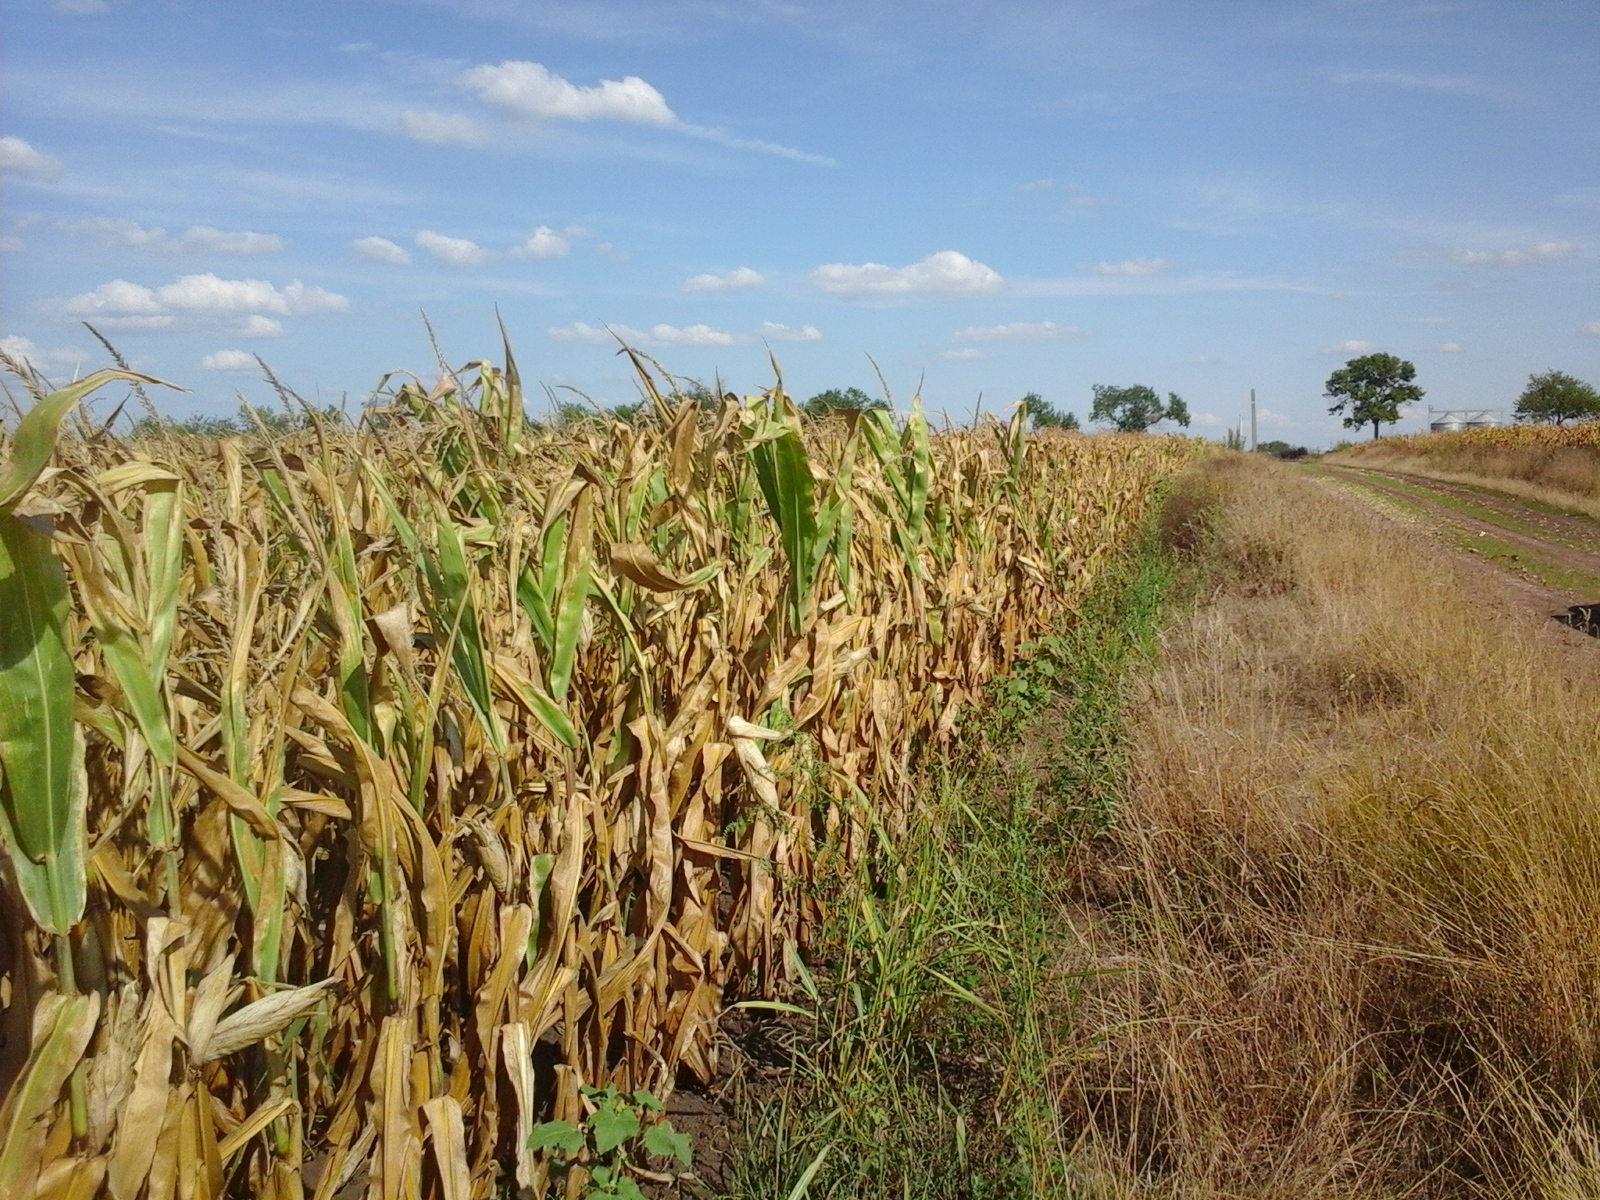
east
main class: Cropland
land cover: Maize
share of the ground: > 75 %
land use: Agriculture (excluding fallow land and kitchen gardens)
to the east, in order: Grass margins; Maize; Electric lines; Maize; Shruby margins; Ditches and canals; Grass margins; Tracks; Grass margins; Lines of trees; Grass margins; Paved roads, cycling and walking lanes; Grass margins; Lines of trees; Grass margins; Maize
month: August
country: RO
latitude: 46.0958
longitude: 21.2994
